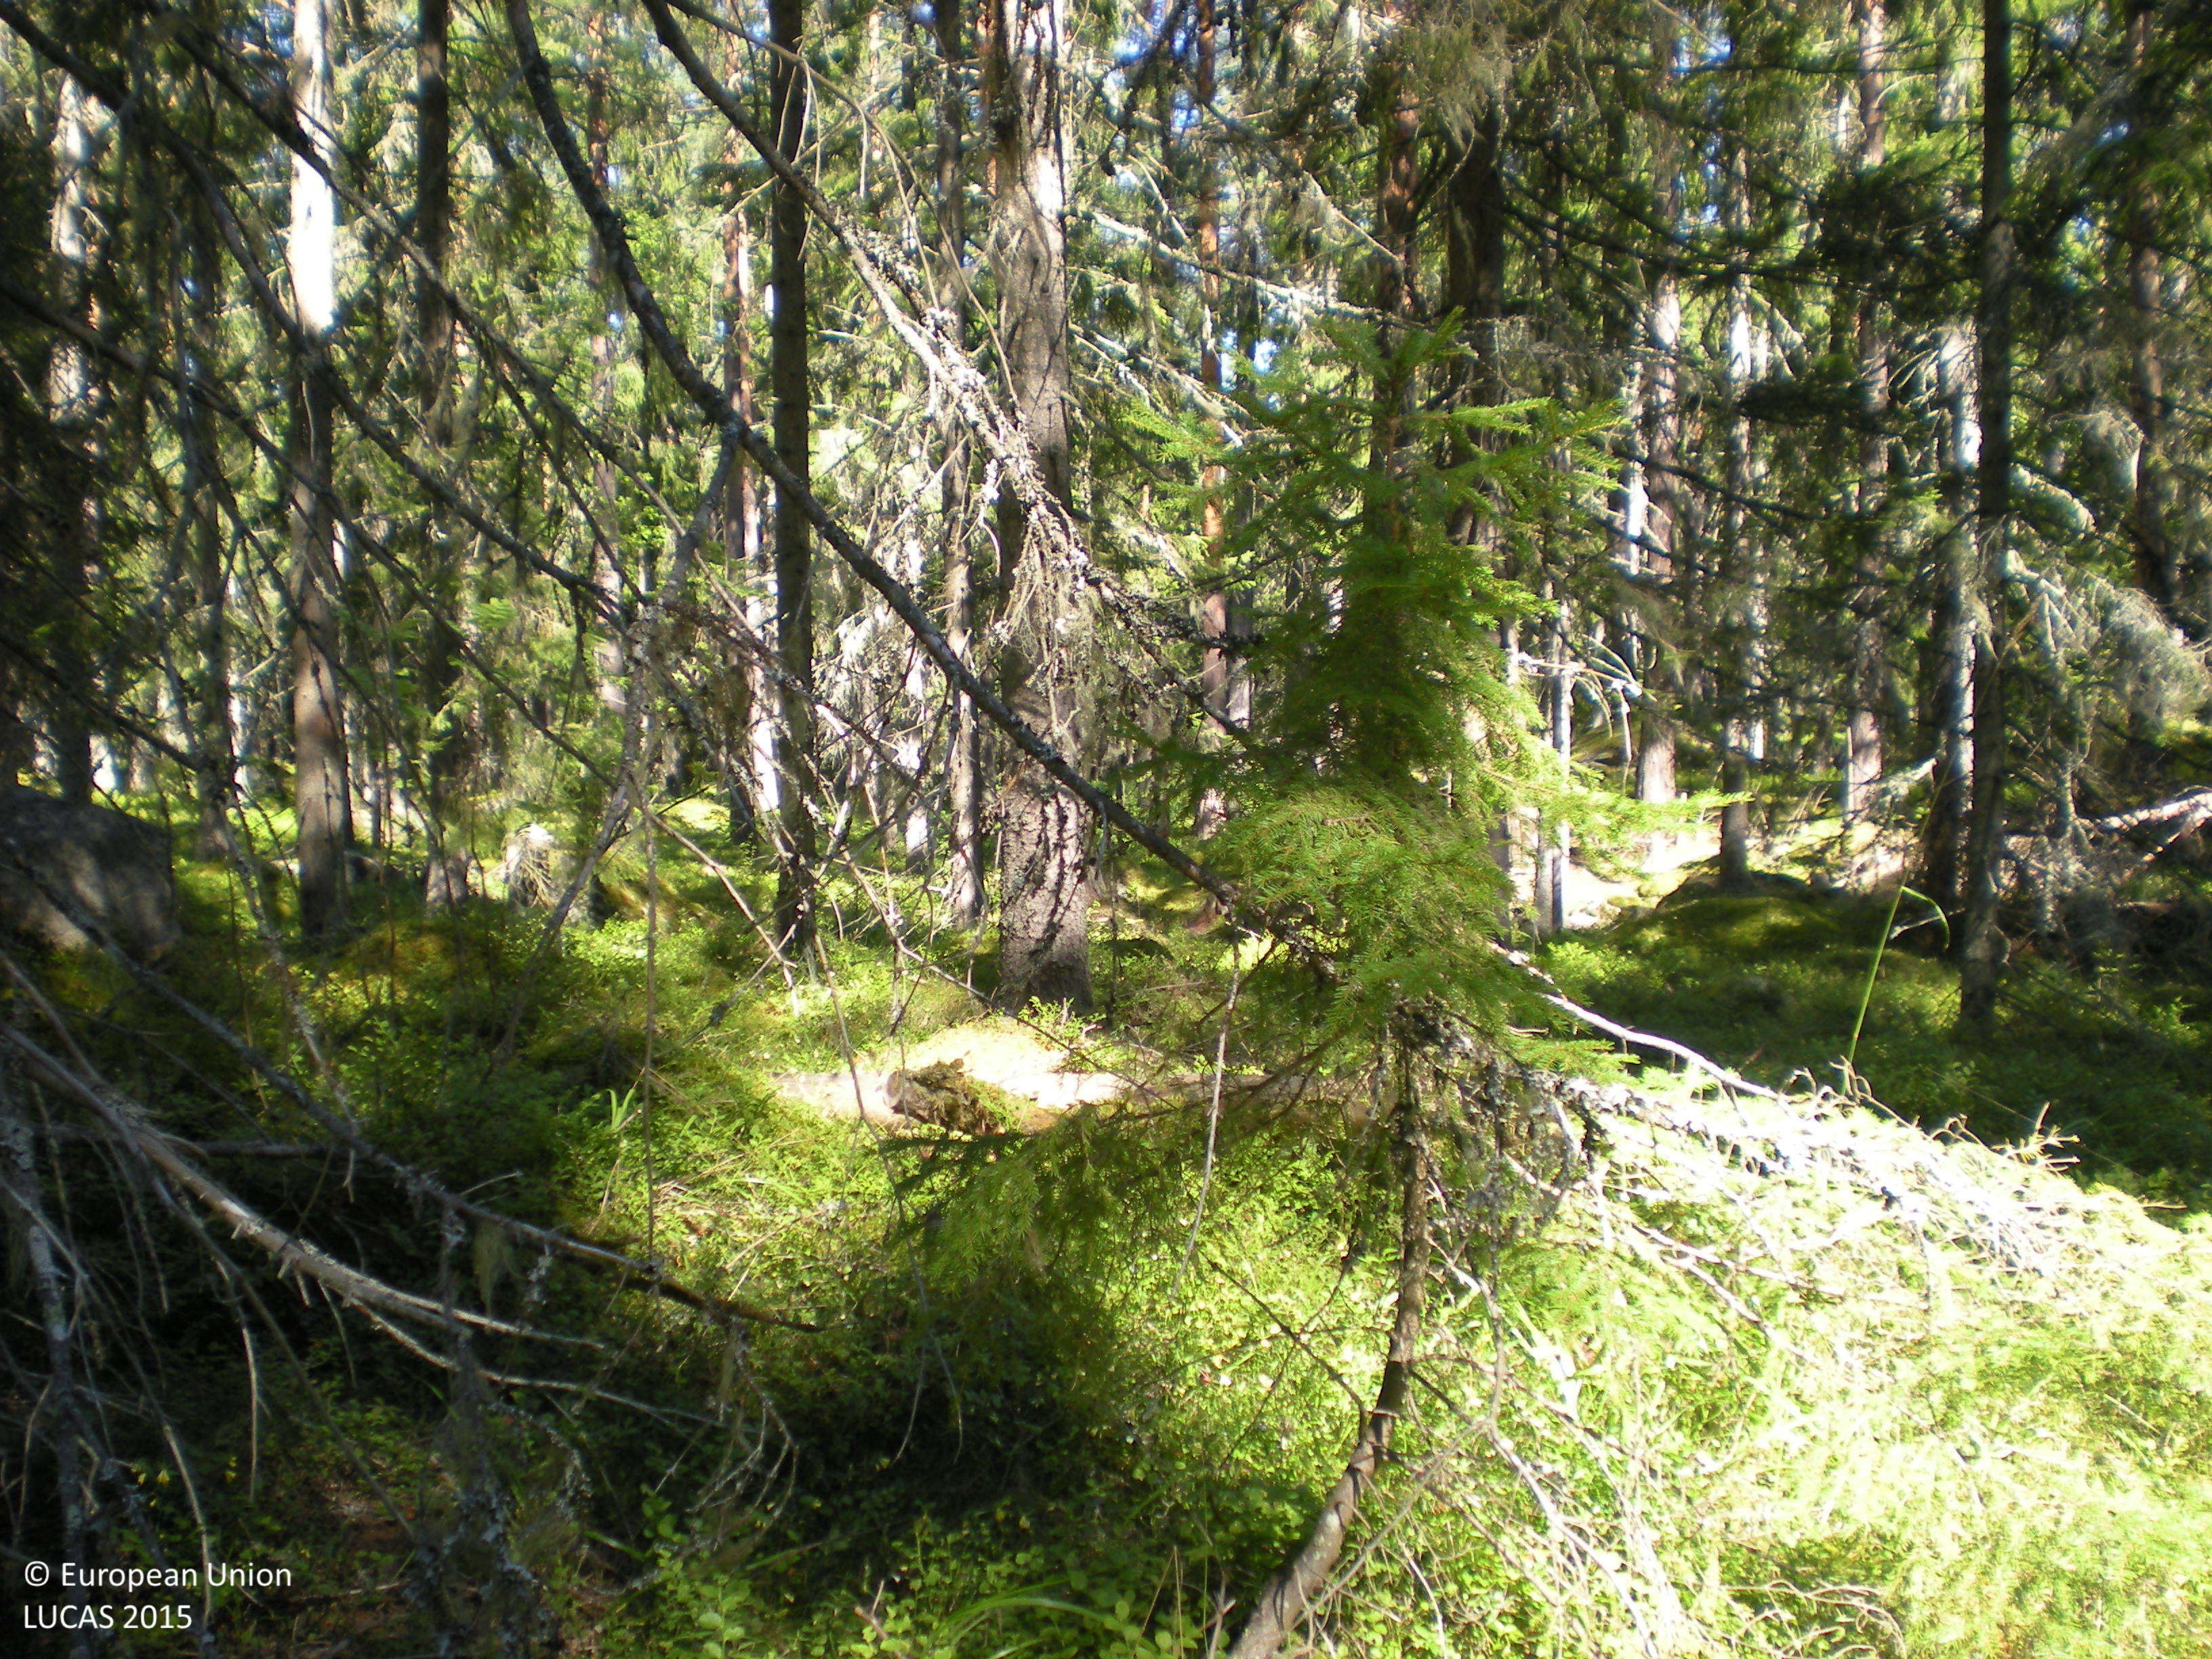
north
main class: Woodland
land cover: Spruce dominated coniferous woodland
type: boreal forest
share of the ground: 50 - 75 %
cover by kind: coniferous forest trees 65 %, shrubs 20 %, herbaceous plants 10 %, lichens and mosses 5 %
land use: Forestry
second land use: Amenities, museums, leisure
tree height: > 5 m
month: August
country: SE
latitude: 60.7064
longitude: 17.1161
